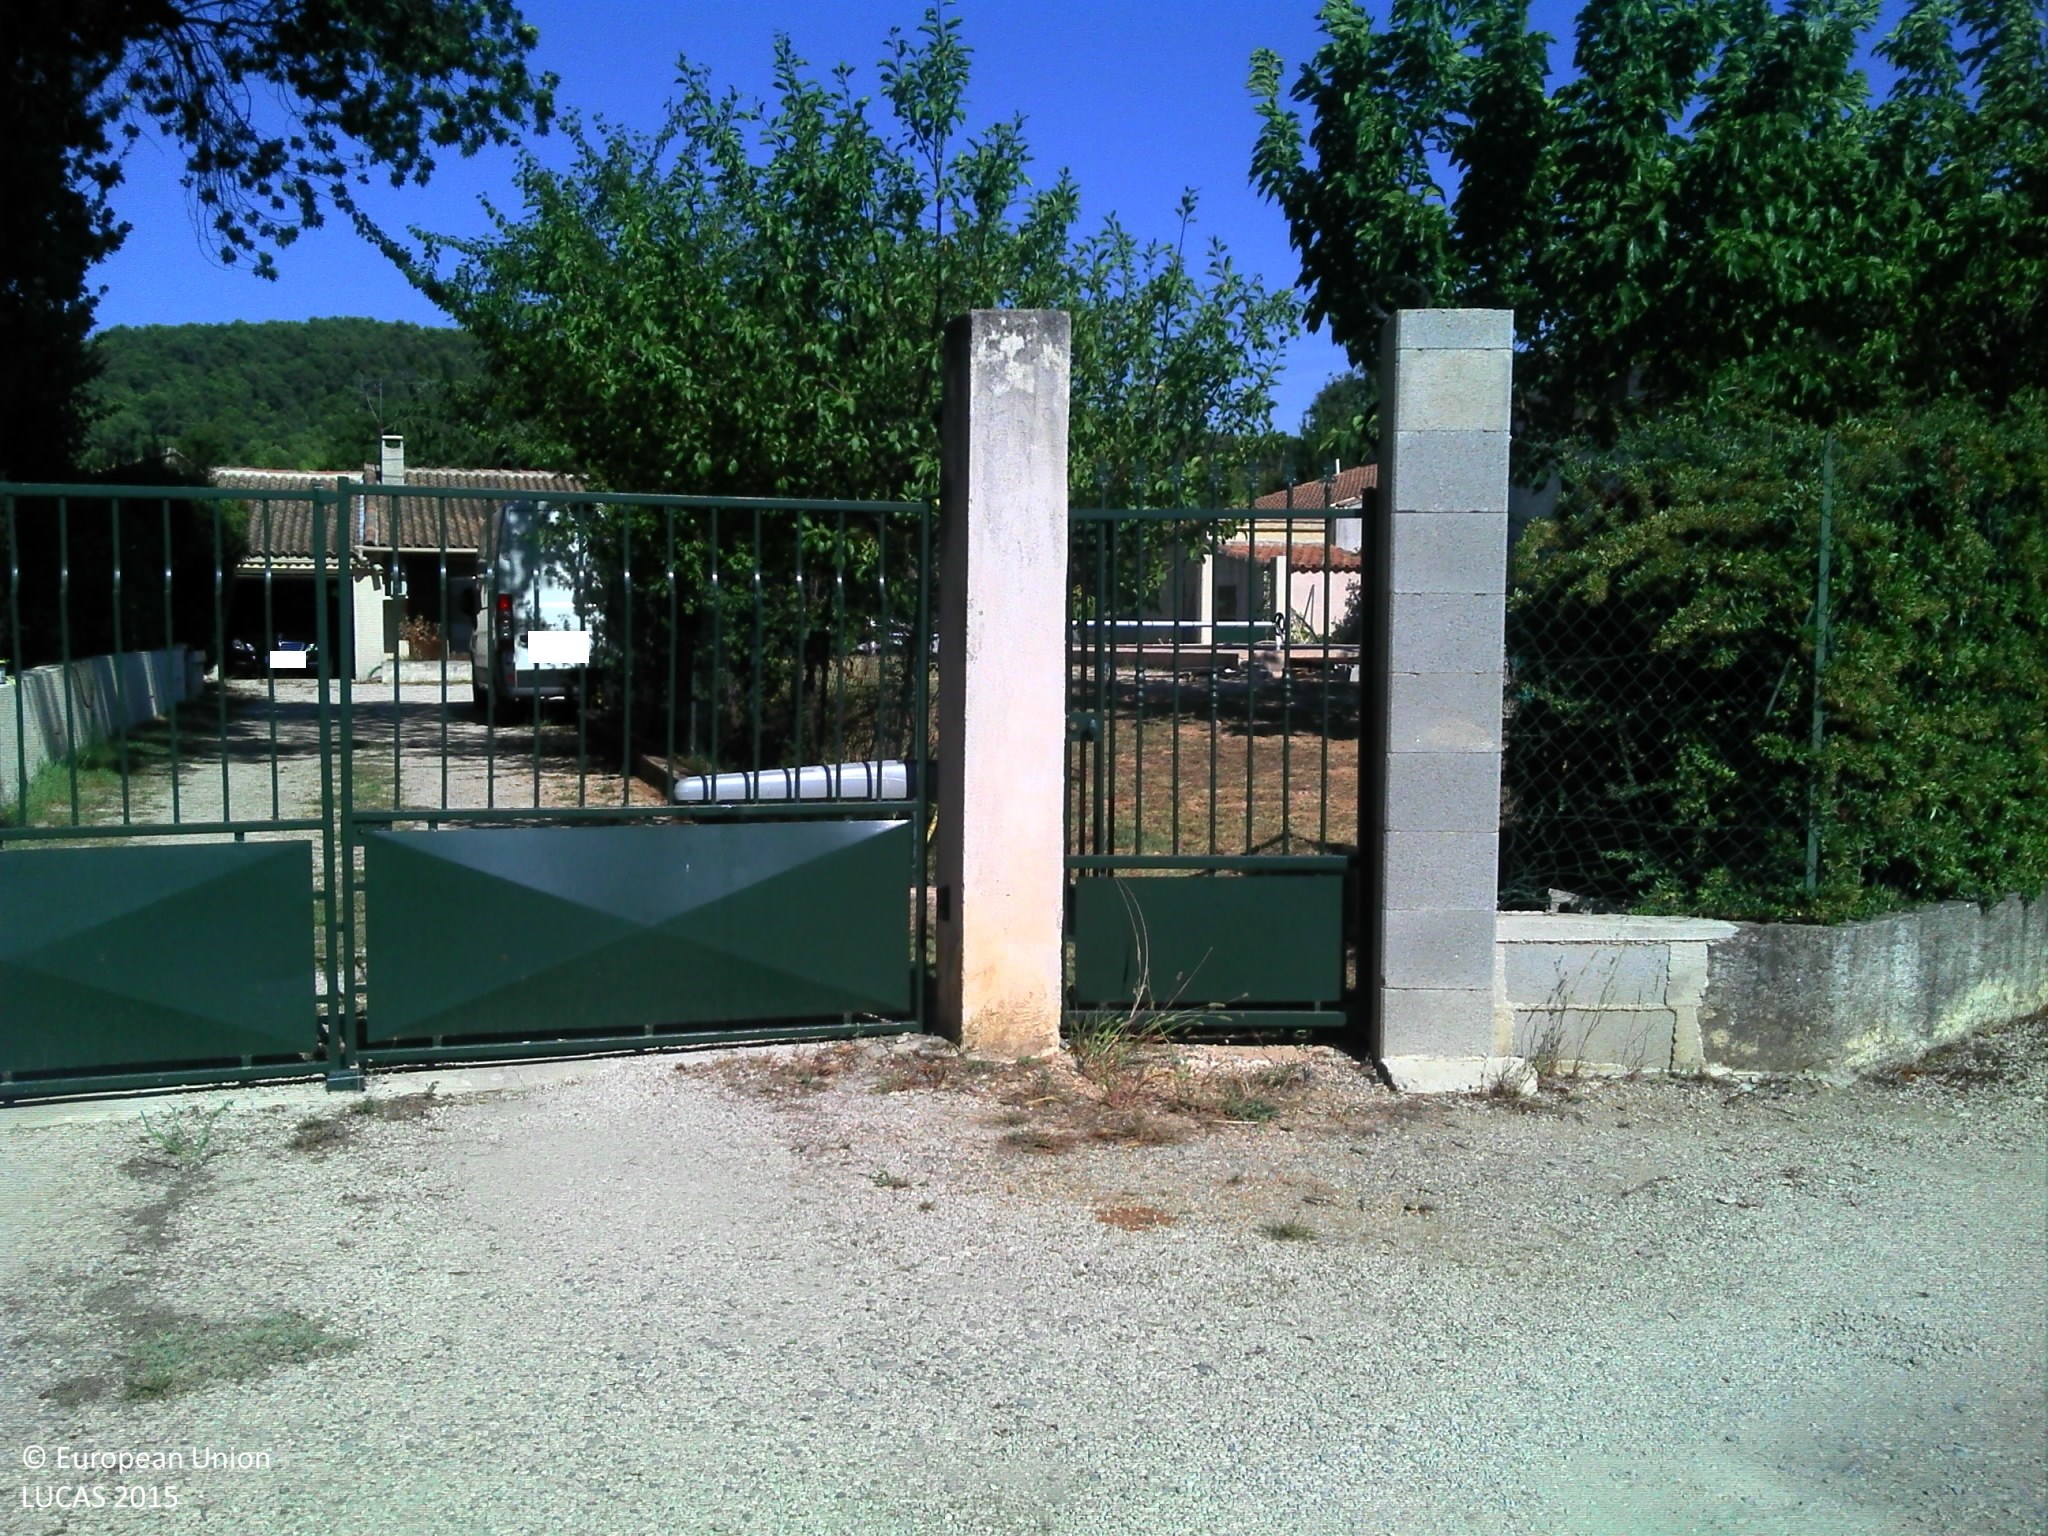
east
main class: Woodland
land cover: Broadleaved woodland
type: thermophilous deciduous forest
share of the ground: > 75 %
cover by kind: broadleaved forest trees 70 %, herbaceous plants 25 %, unconsolidated bare surface 5 %
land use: Residential
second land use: Forestry
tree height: > 5 m
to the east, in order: Broadleaved woodland; Artificial constructions in urban areas
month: August
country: FR
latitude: 43.3902
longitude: 5.6027
